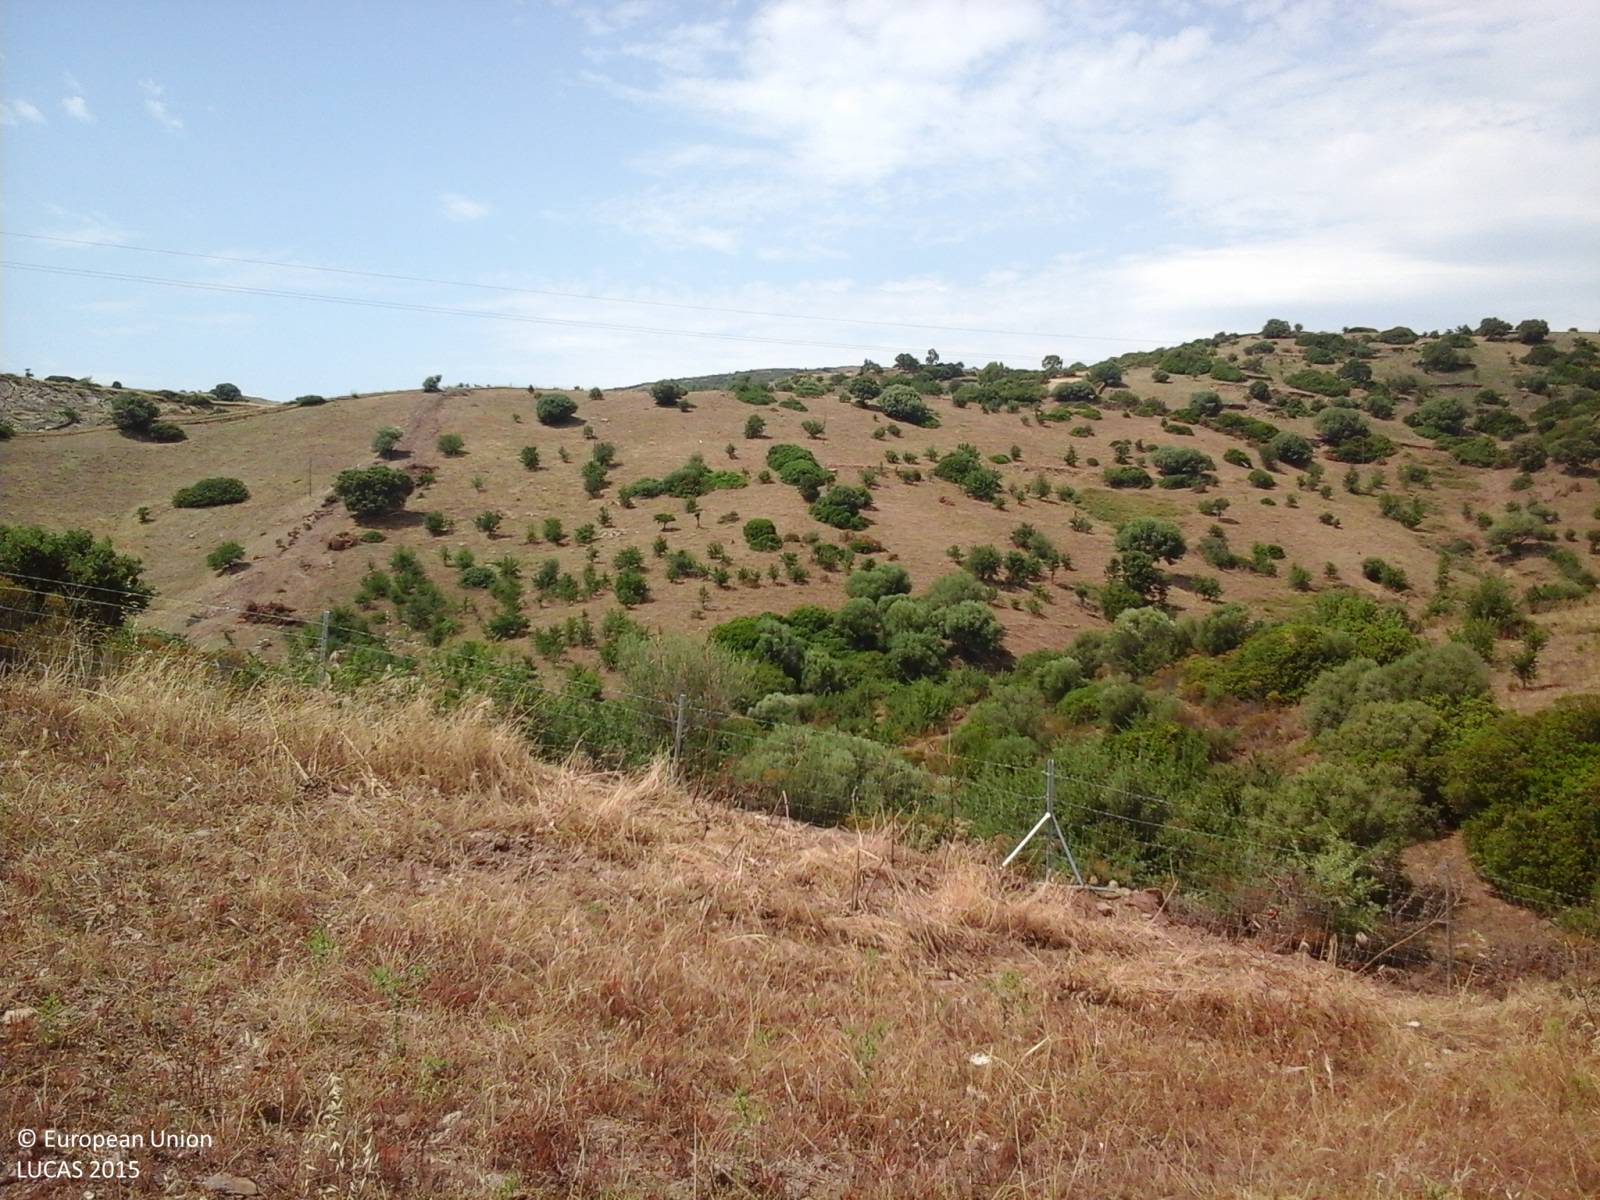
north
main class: Cropland
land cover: Mixed cereals for fodder
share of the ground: > 75 %
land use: Agriculture (excluding fallow land and kitchen gardens)
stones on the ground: > 50 %
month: June
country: IT
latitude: 40.4469
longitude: 9.4721
